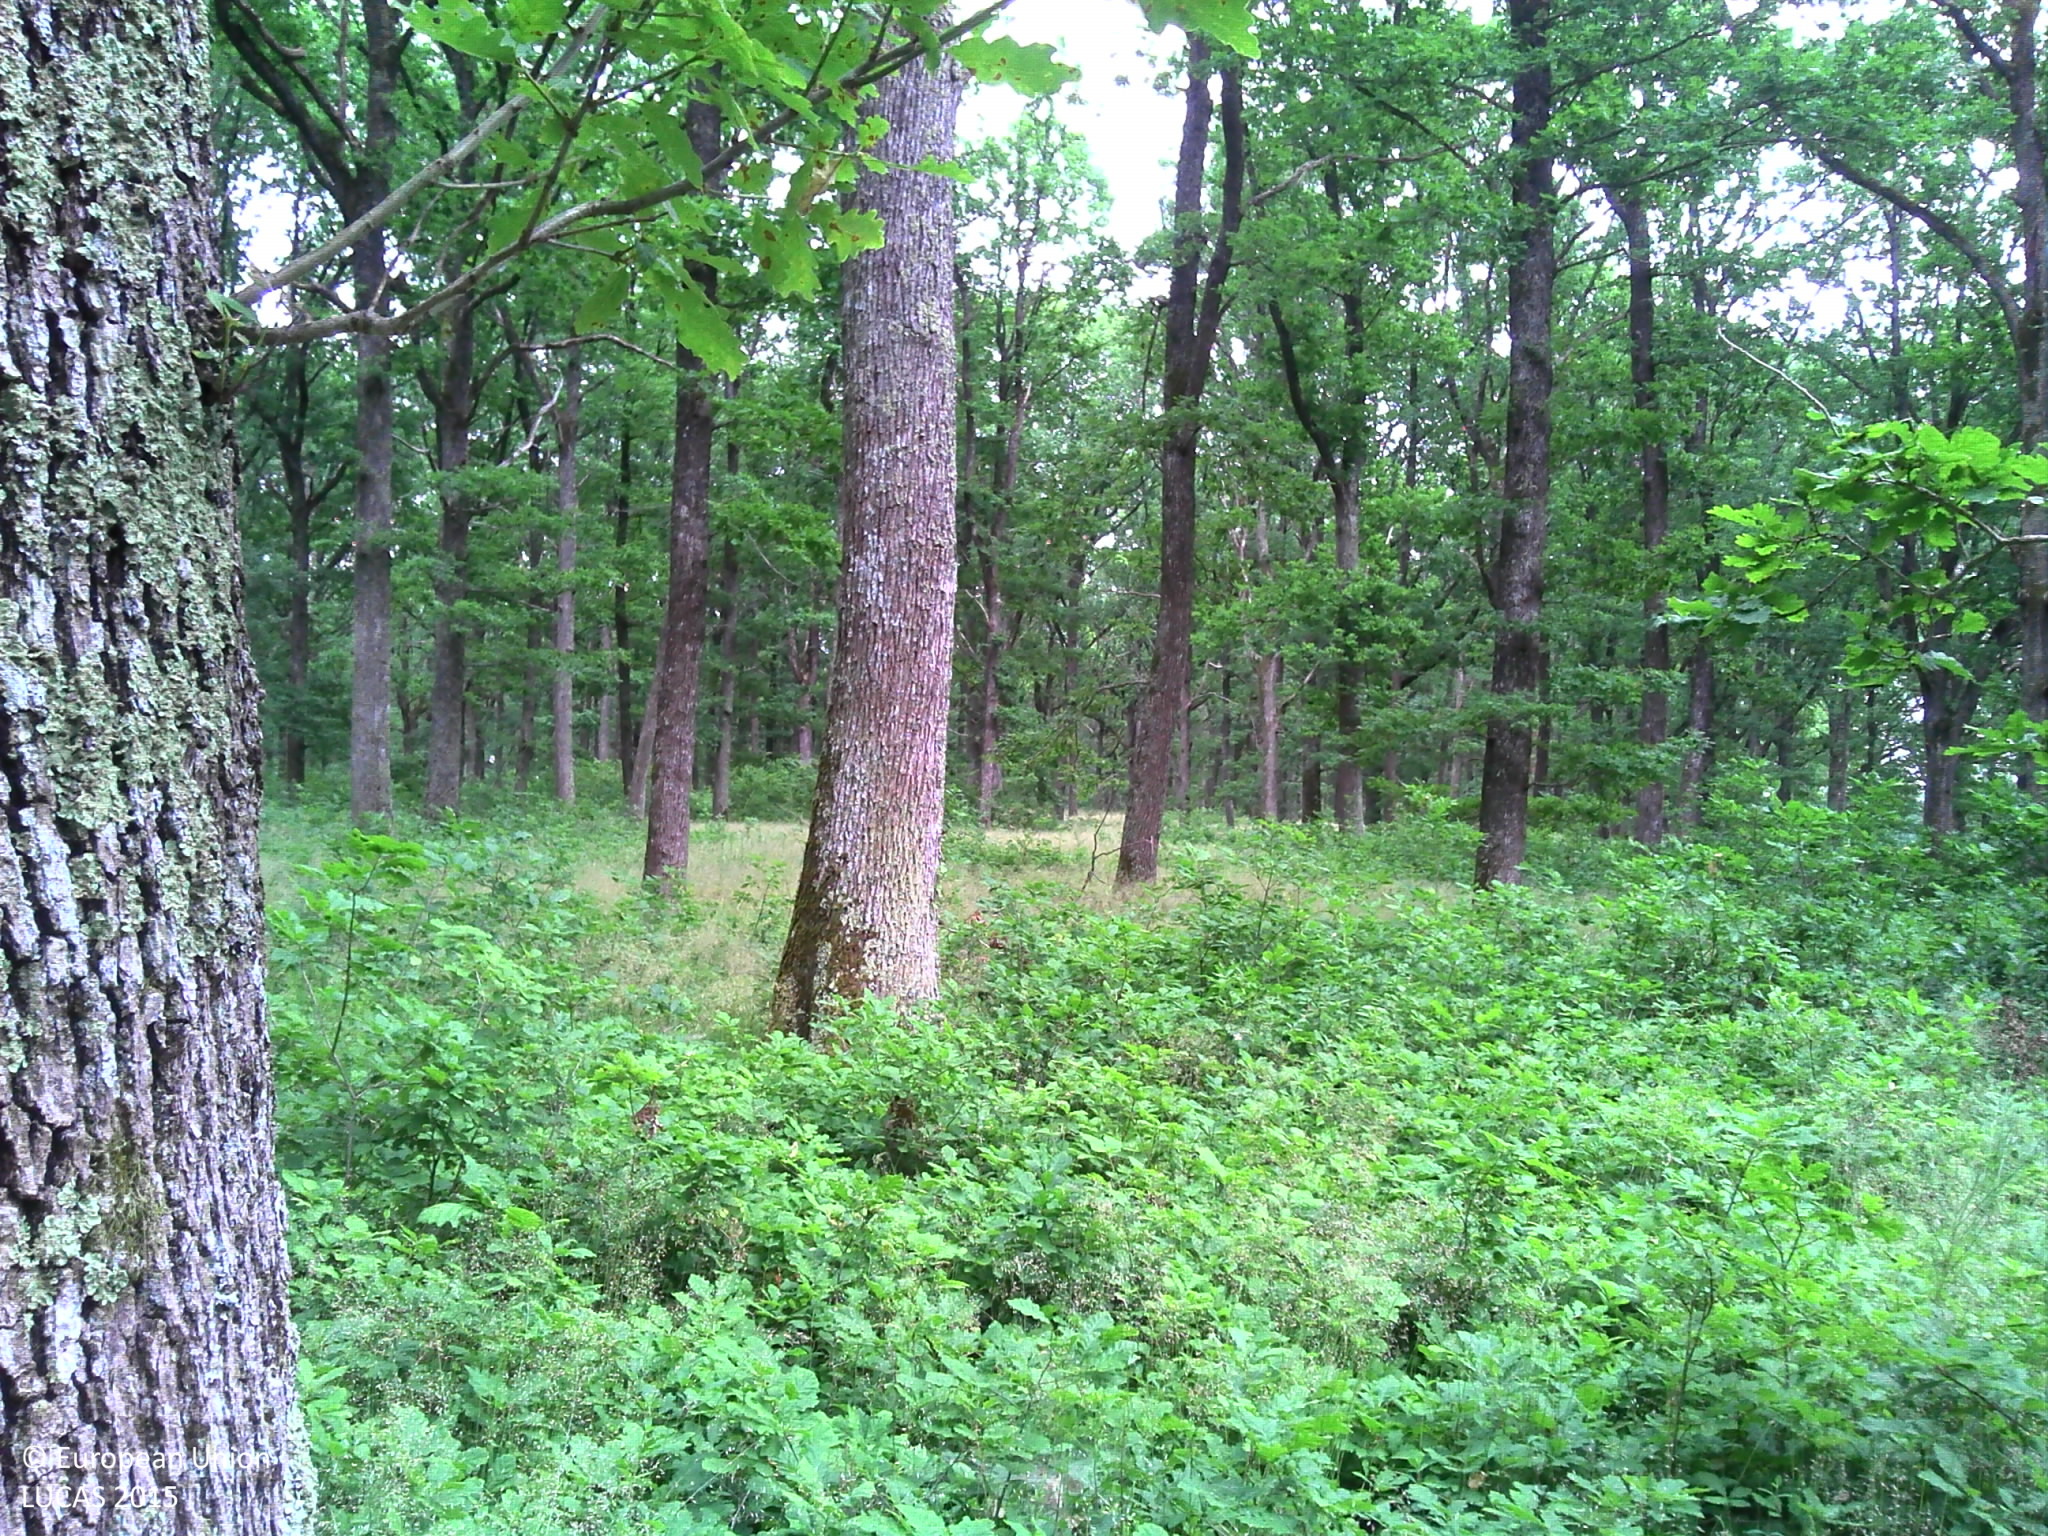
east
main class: Woodland
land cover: Broadleaved woodland
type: acidophilous oak and oak-birch forest
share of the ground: > 75 %
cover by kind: broadleaved forest trees 90 %, herbaceous plants 10 %
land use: Forestry
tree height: > 5 m
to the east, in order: Broadleaved woodland; Ditches and canals; Broadleaved woodland; Tracks; Ditches and canals; Broadleaved woodland
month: June
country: FR
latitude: 46.3962
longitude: 2.7785
